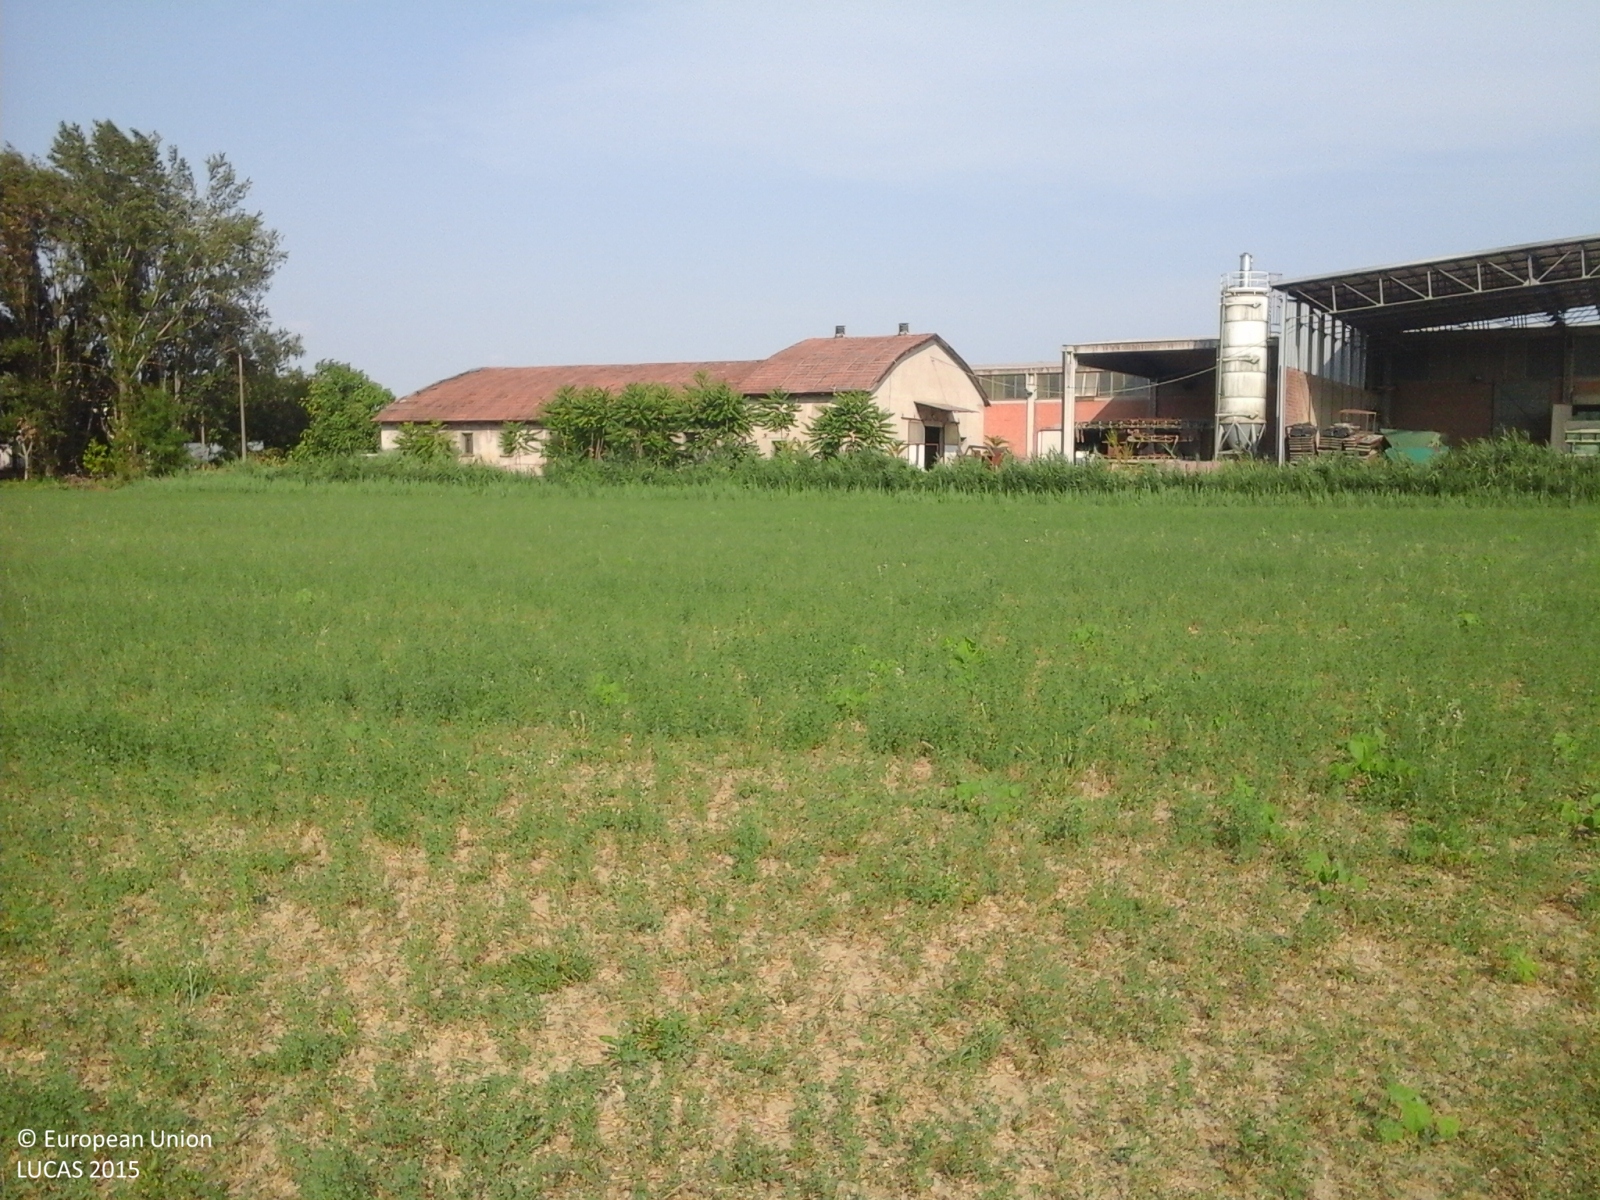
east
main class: Cropland
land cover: Lucerne
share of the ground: 25 - 50 %
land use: Agriculture (excluding fallow land and kitchen gardens)
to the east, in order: Lucerne; Grass margins; Artificial constructions in urban areas; Abandoned hedges; Inland fresh running water; Abandoned hedges; Spontaneously vegetated surfaces; Paved roads, cycling and walking lanes; Electric lines; Abandoned hedges
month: July
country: IT
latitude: 44.9426
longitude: 10.7968
